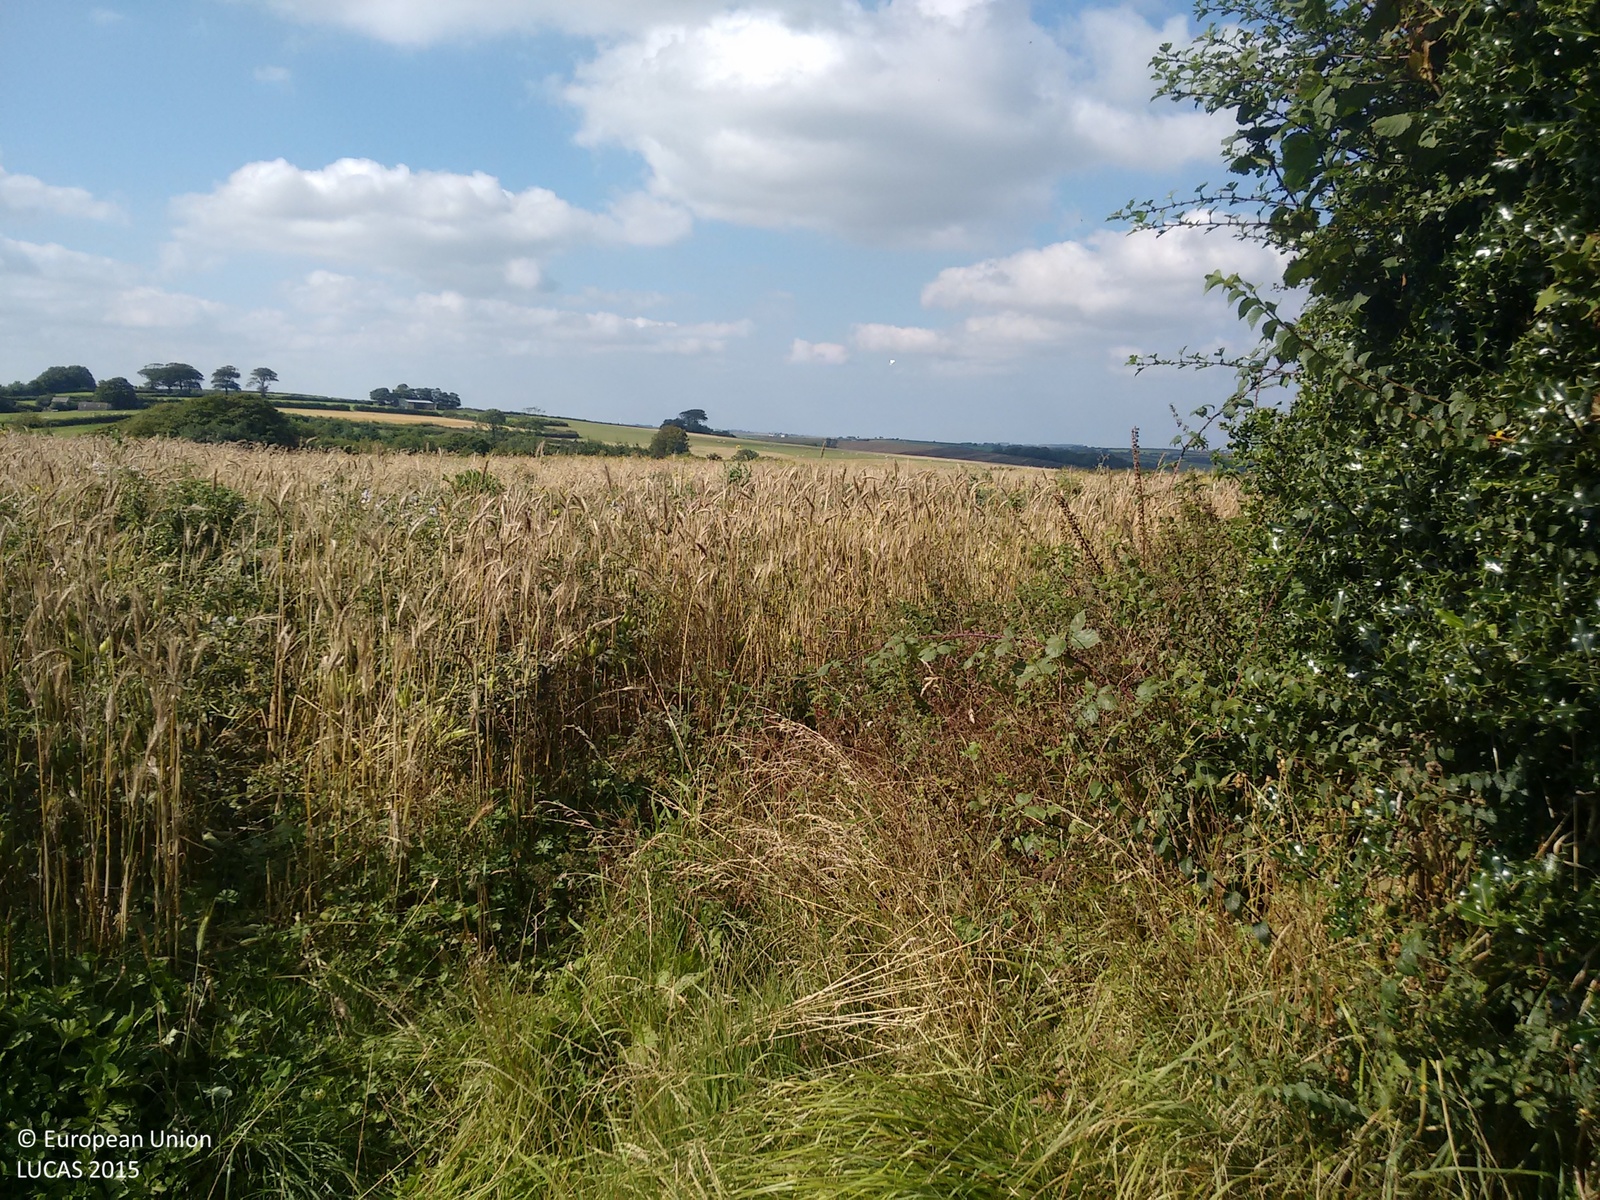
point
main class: Cropland
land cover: Barley
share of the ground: > 75 %
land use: Agriculture (excluding fallow land and kitchen gardens)
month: September
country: GB
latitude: 50.9193
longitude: -4.1662
